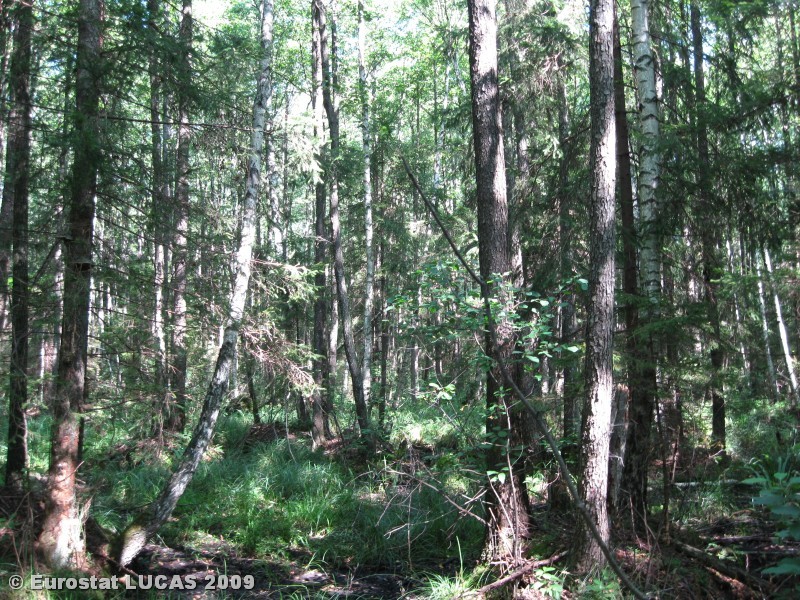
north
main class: Woodland
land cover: Broadleaved woodland
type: non-riverine alder, birch or aspen forest
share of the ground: > 75 %
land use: Forestry
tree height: > 5 m
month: August
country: LT
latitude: 54.9031
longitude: 23.5087
